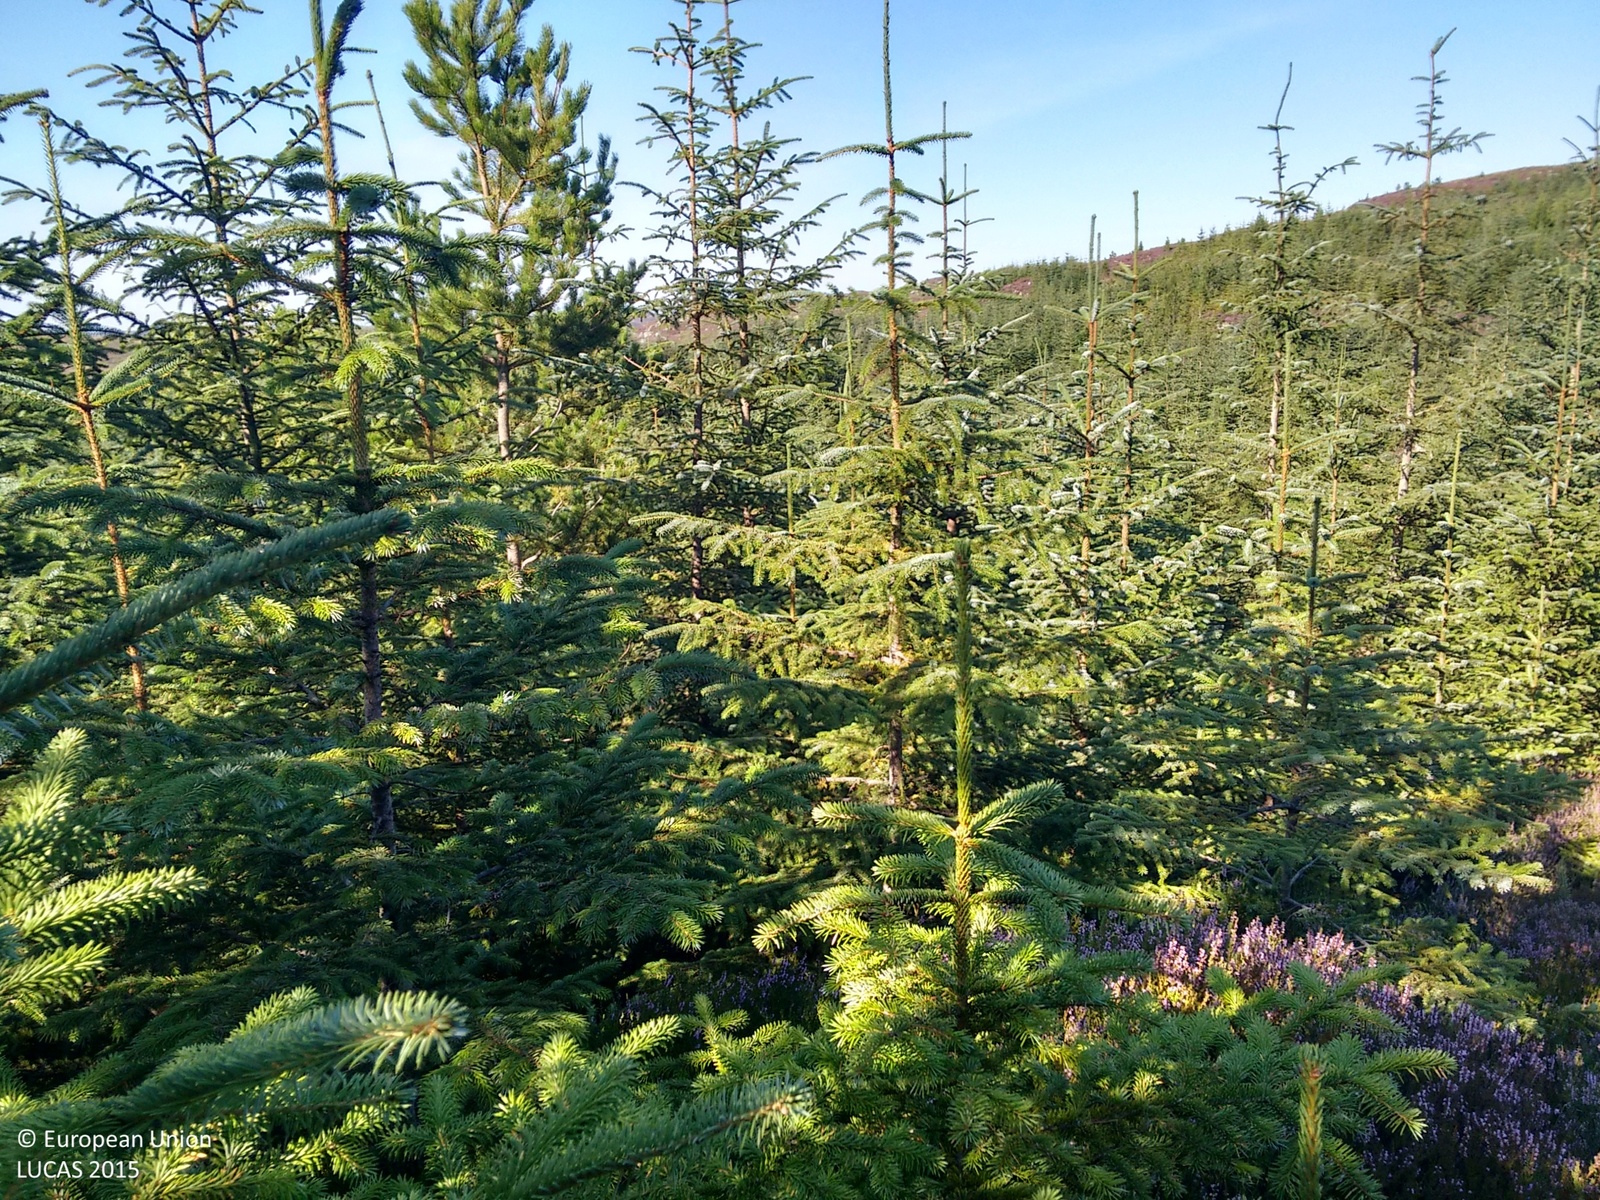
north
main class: Woodland
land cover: Spruce dominated coniferous woodland
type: exotic forest
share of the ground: > 75 %
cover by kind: coniferous forest trees 95 %, shrubs 5 %
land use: Forestry
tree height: > 5 m
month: September
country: GB
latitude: 58.4790
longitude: -4.2622
